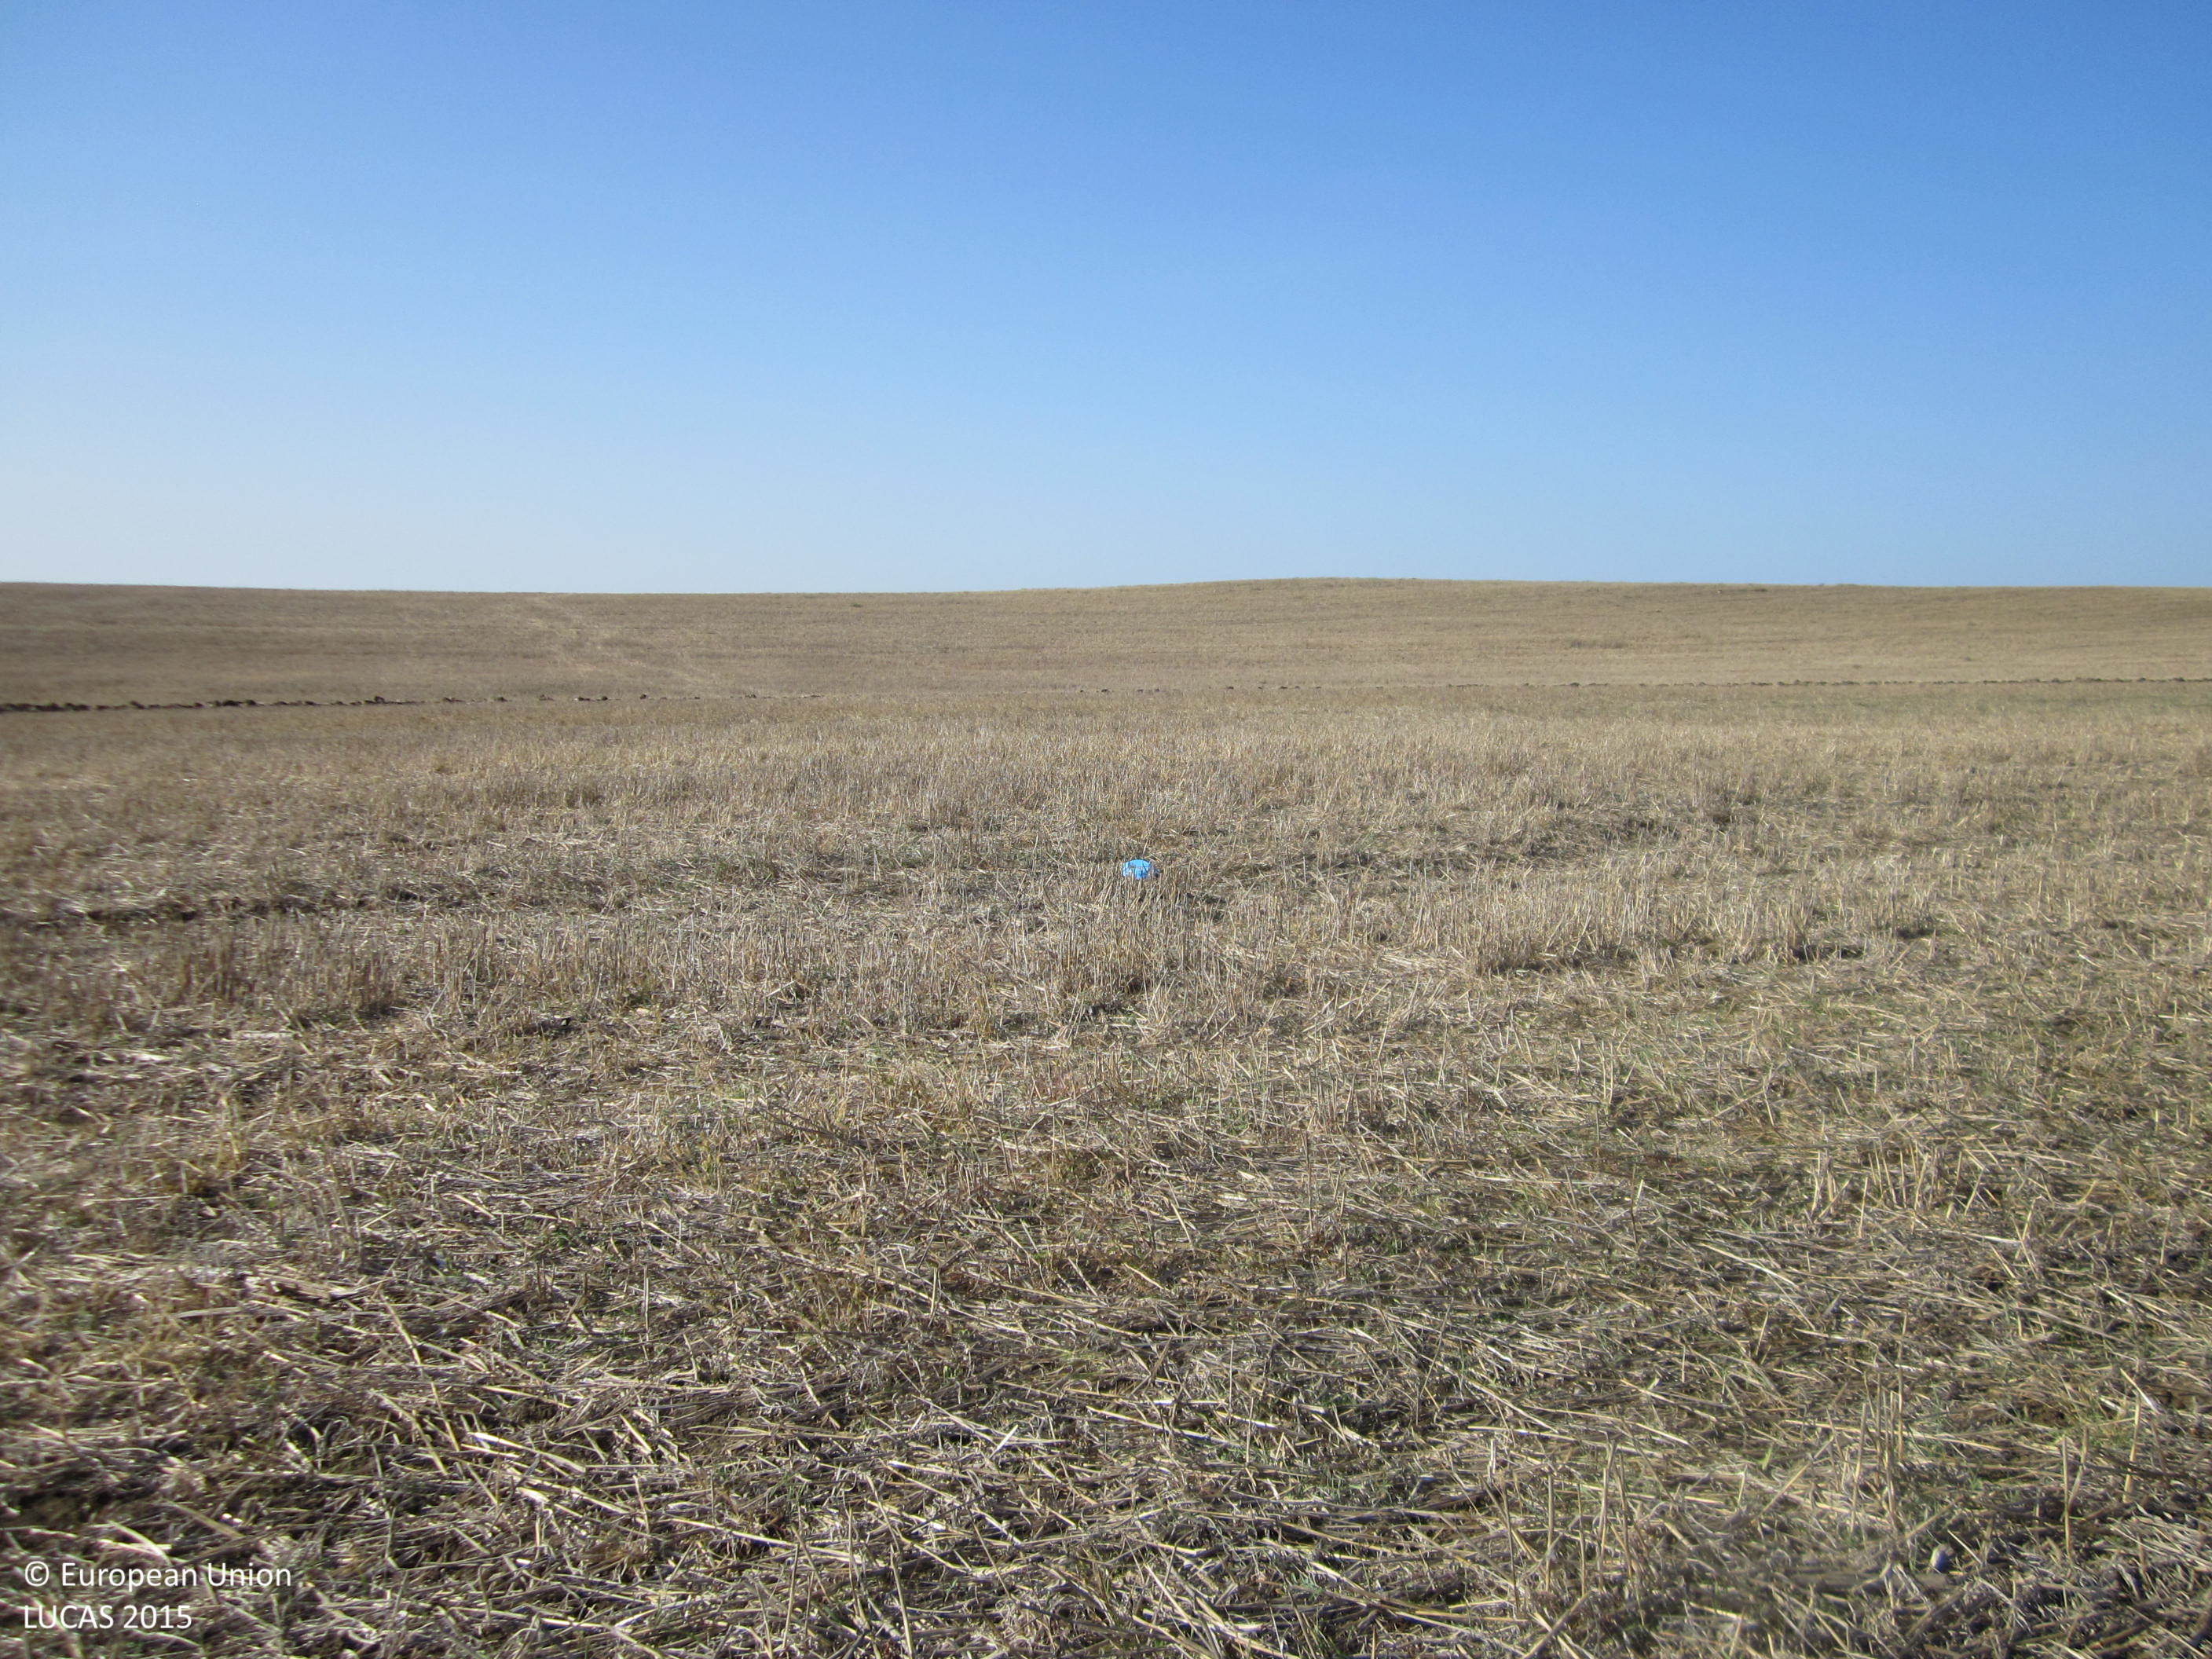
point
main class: Cropland
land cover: Common wheat
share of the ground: 10 - 25 %
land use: Agriculture (excluding fallow land and kitchen gardens)
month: September
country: BG
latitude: 42.6847
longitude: 27.3866
